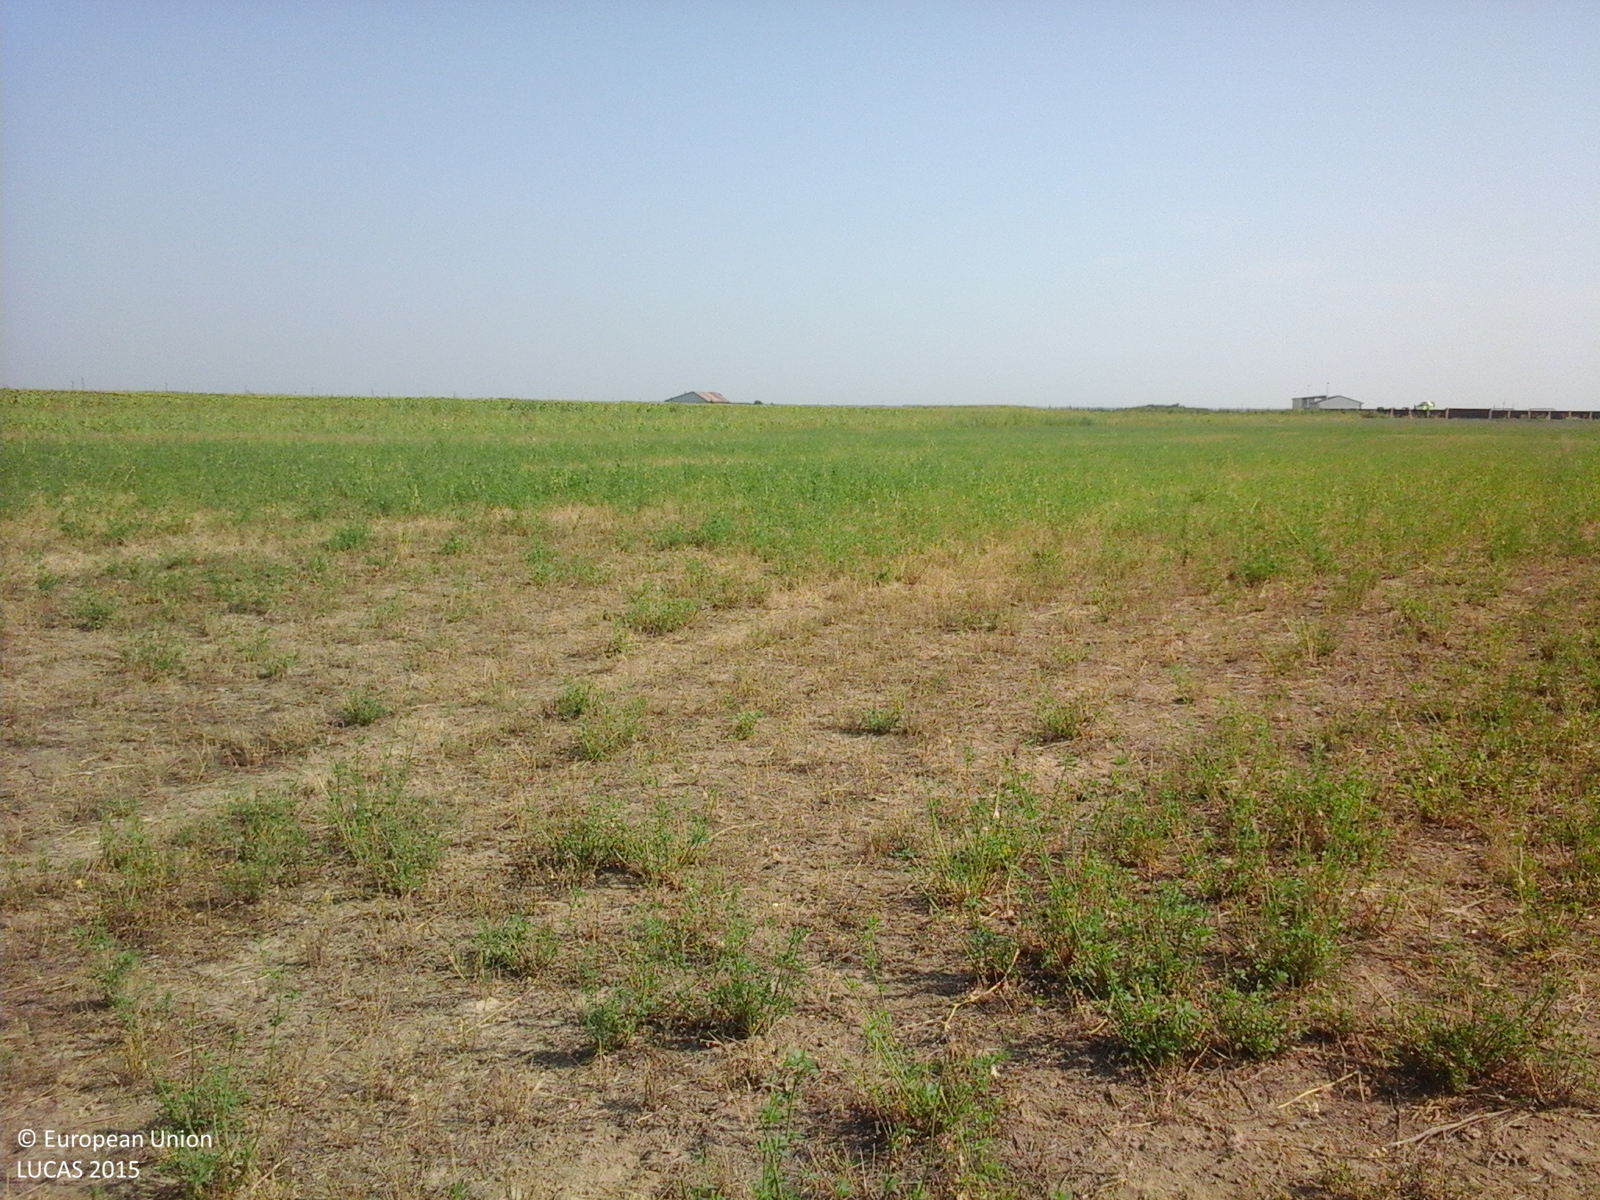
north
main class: Cropland
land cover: Lucerne
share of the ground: 25 - 50 %
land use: Agriculture (excluding fallow land and kitchen gardens)
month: August
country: RO
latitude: 45.3384
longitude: 27.8100
